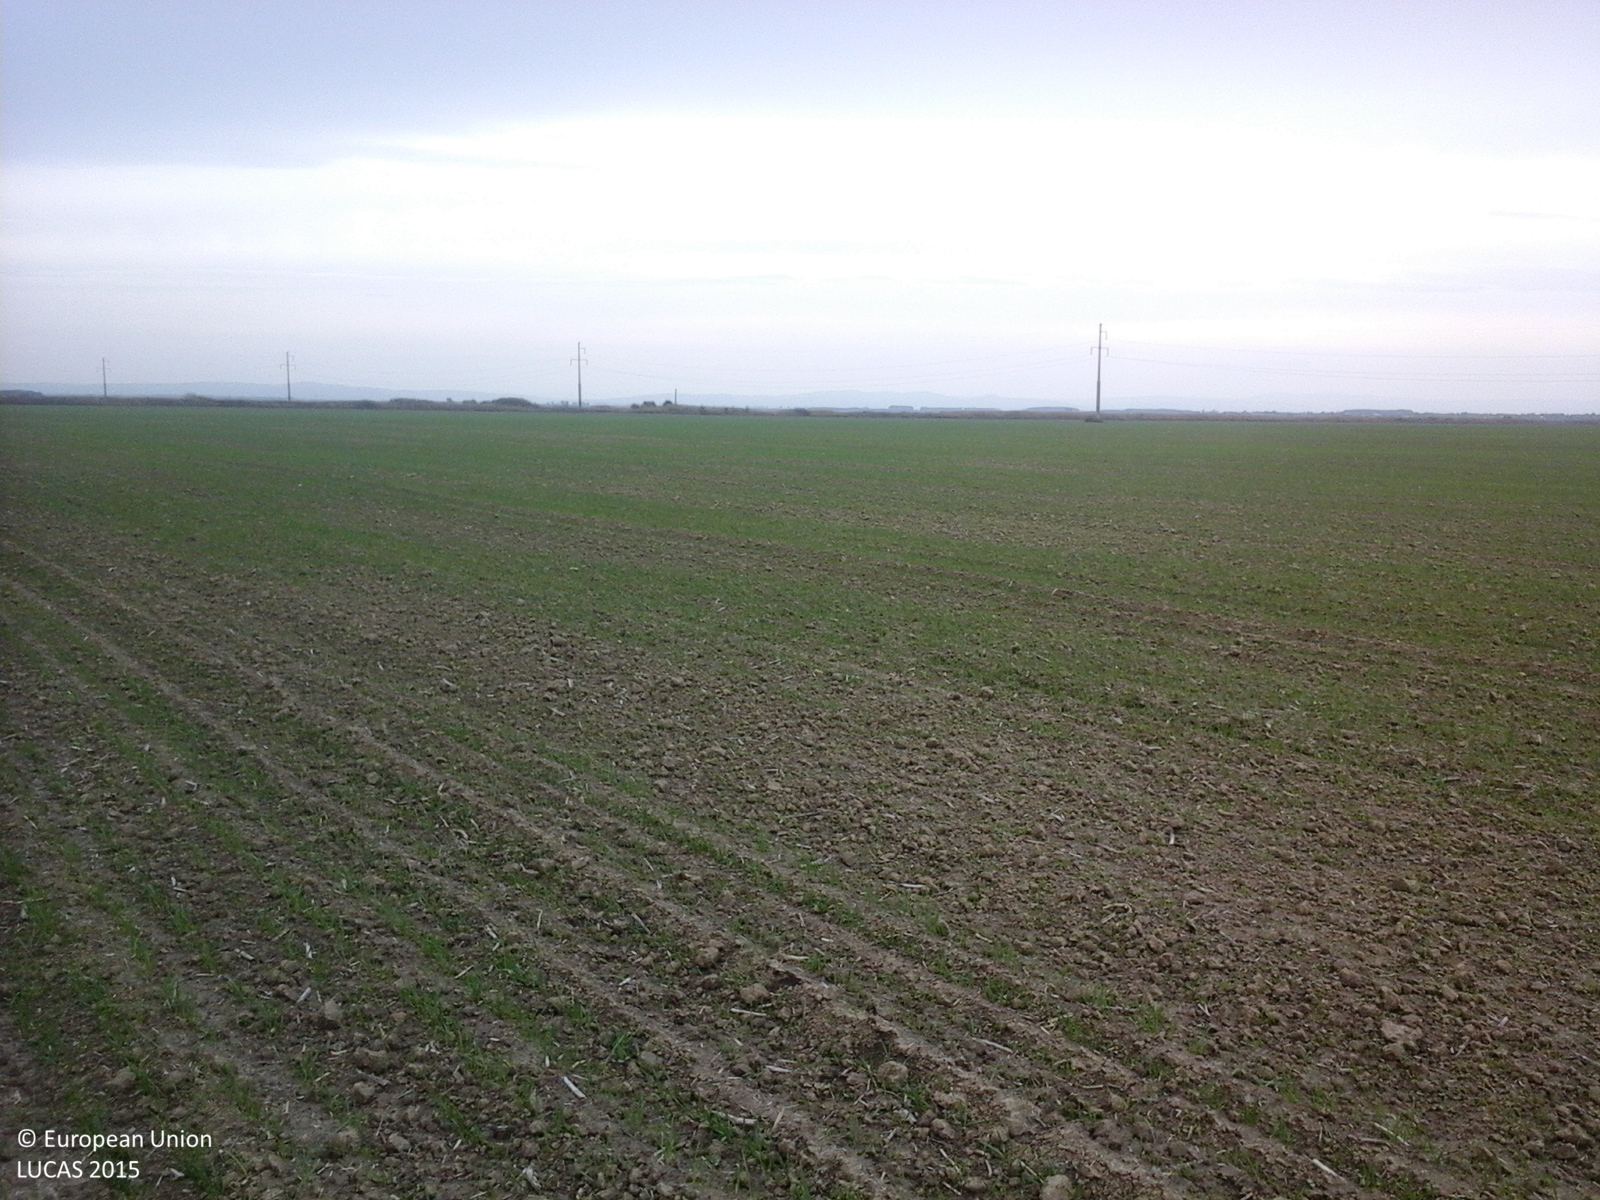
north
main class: Cropland
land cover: Common wheat
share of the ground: 25 - 50 %
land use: Agriculture (excluding fallow land and kitchen gardens)
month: October
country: RO
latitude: 44.8264
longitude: 26.3420
